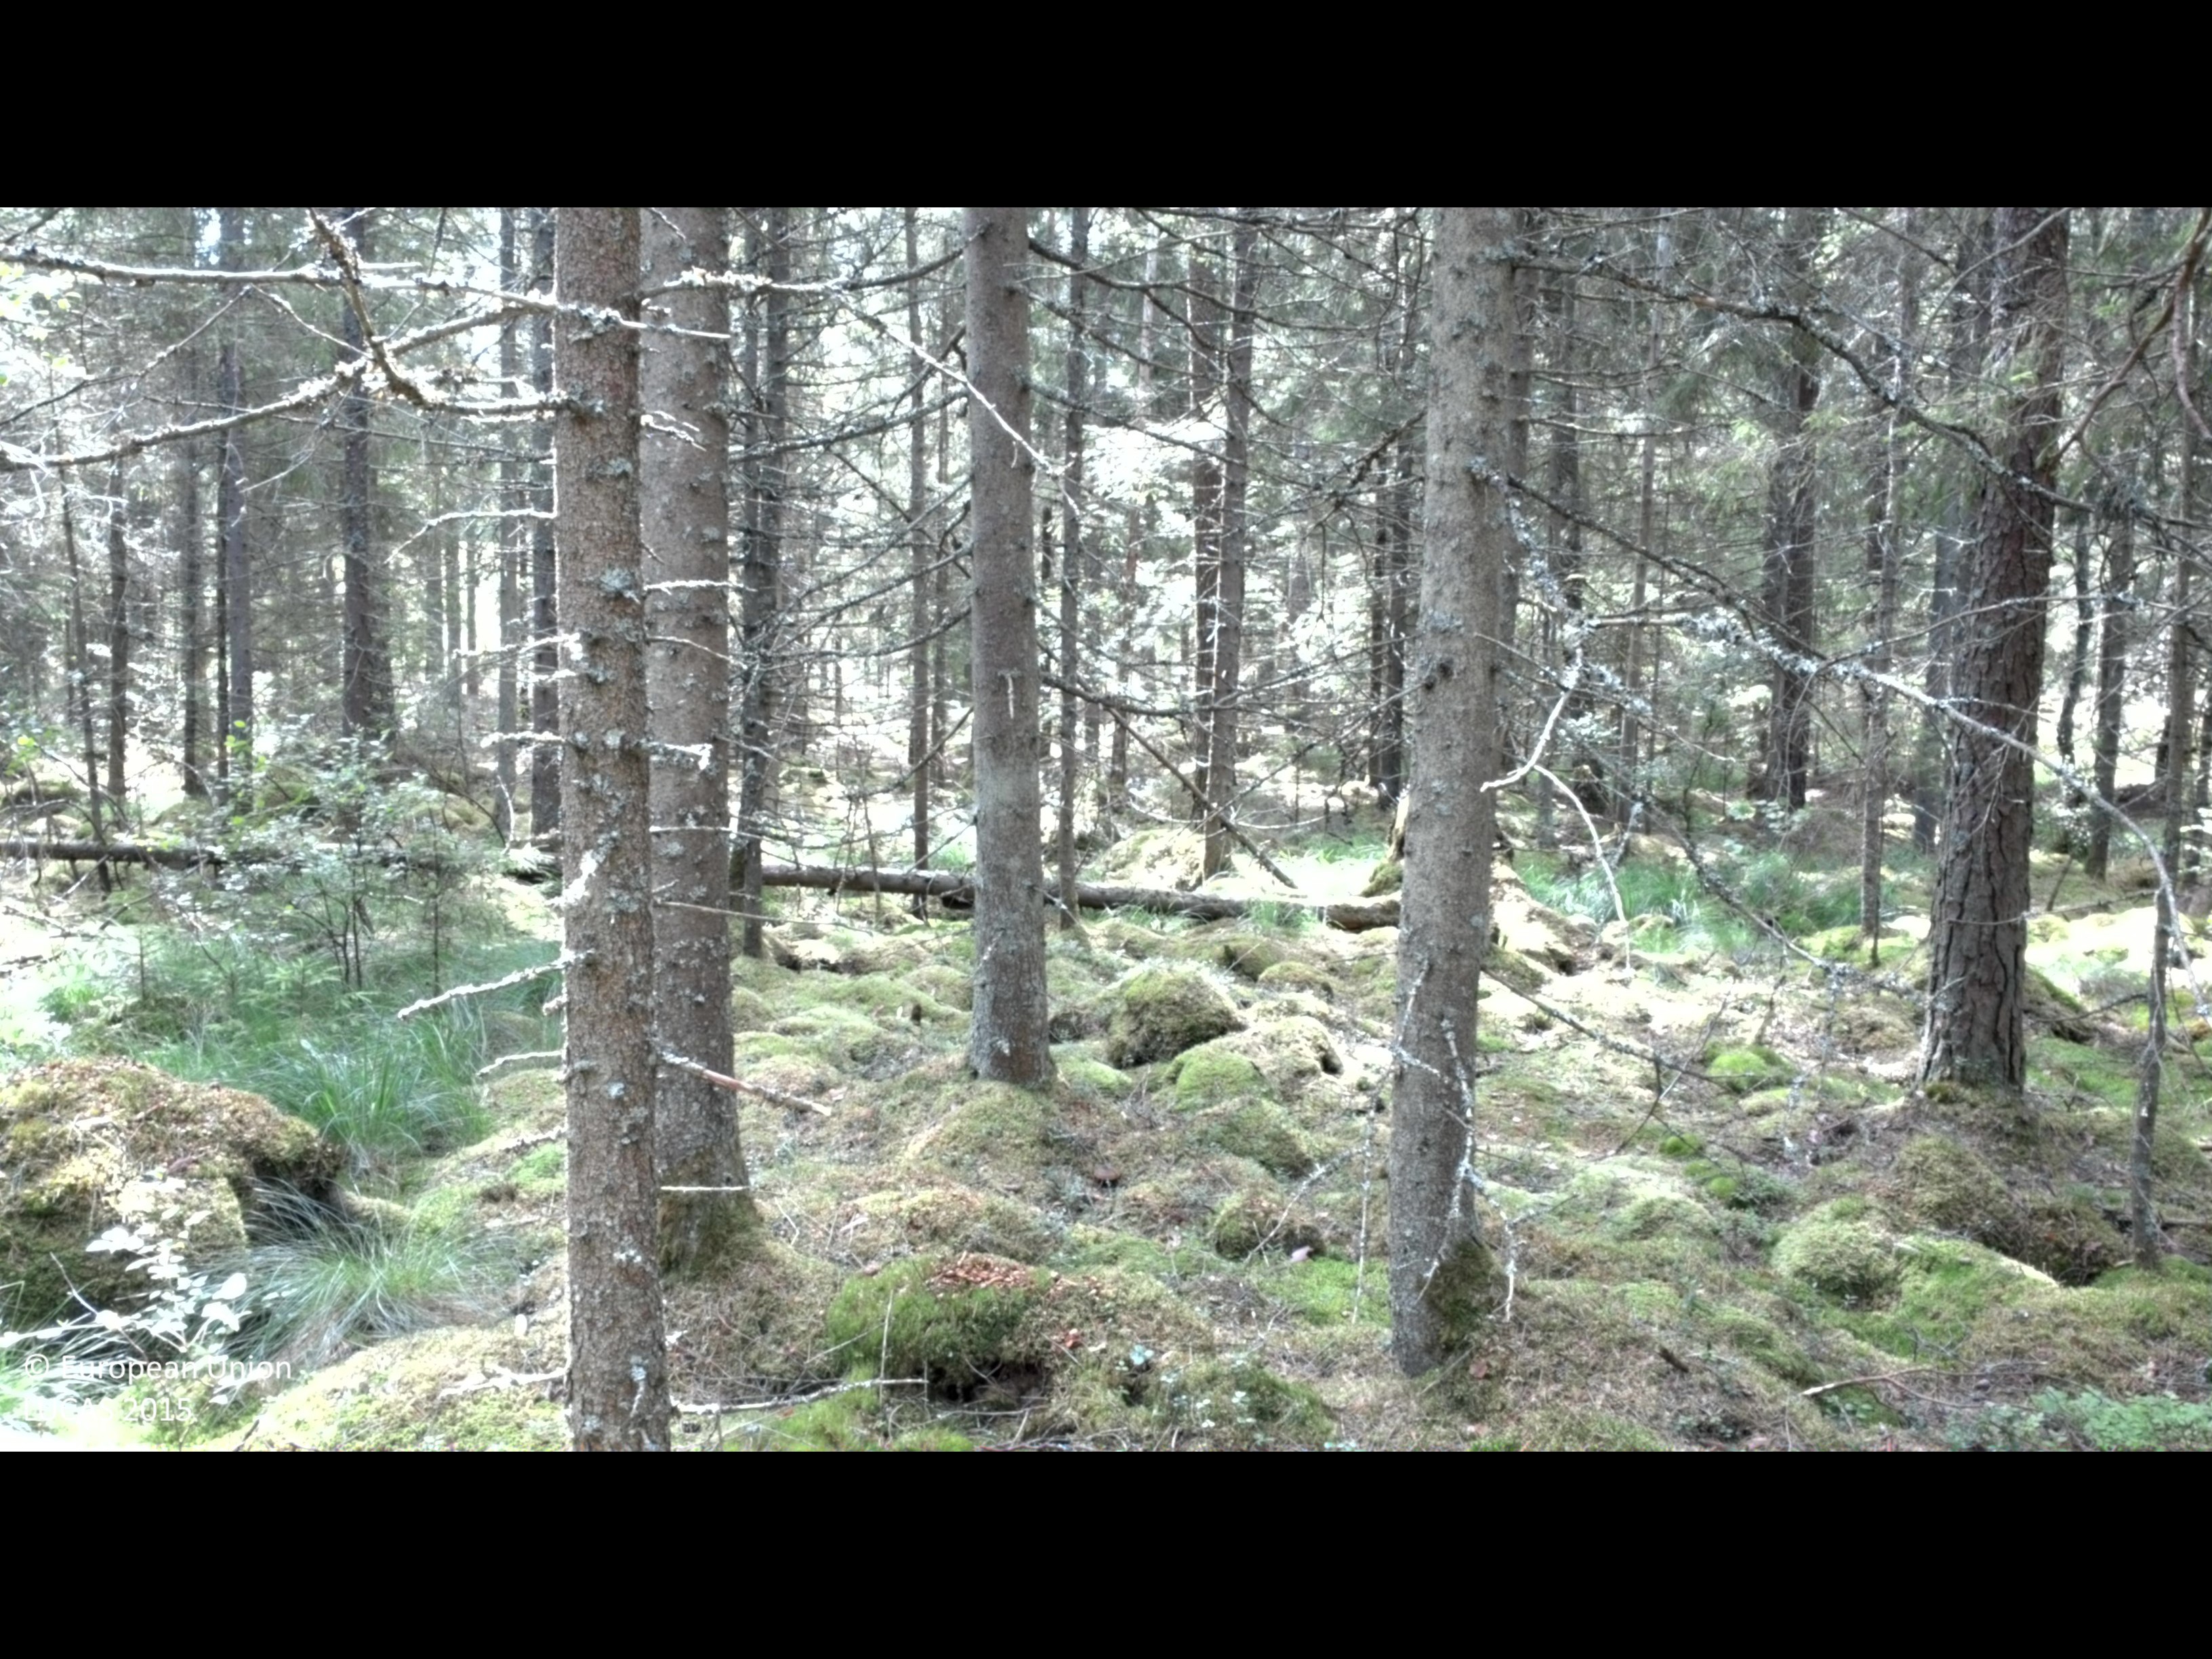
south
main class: Woodland
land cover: Spruce dominated coniferous woodland
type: boreal forest
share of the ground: > 75 %
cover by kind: coniferous forest trees 80 %, herbaceous plants 10 %, broadleaved forest trees 5 %, shrubs 5 %
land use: Forestry
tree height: > 5 m
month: August
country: SE
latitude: 56.7443
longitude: 13.7737
